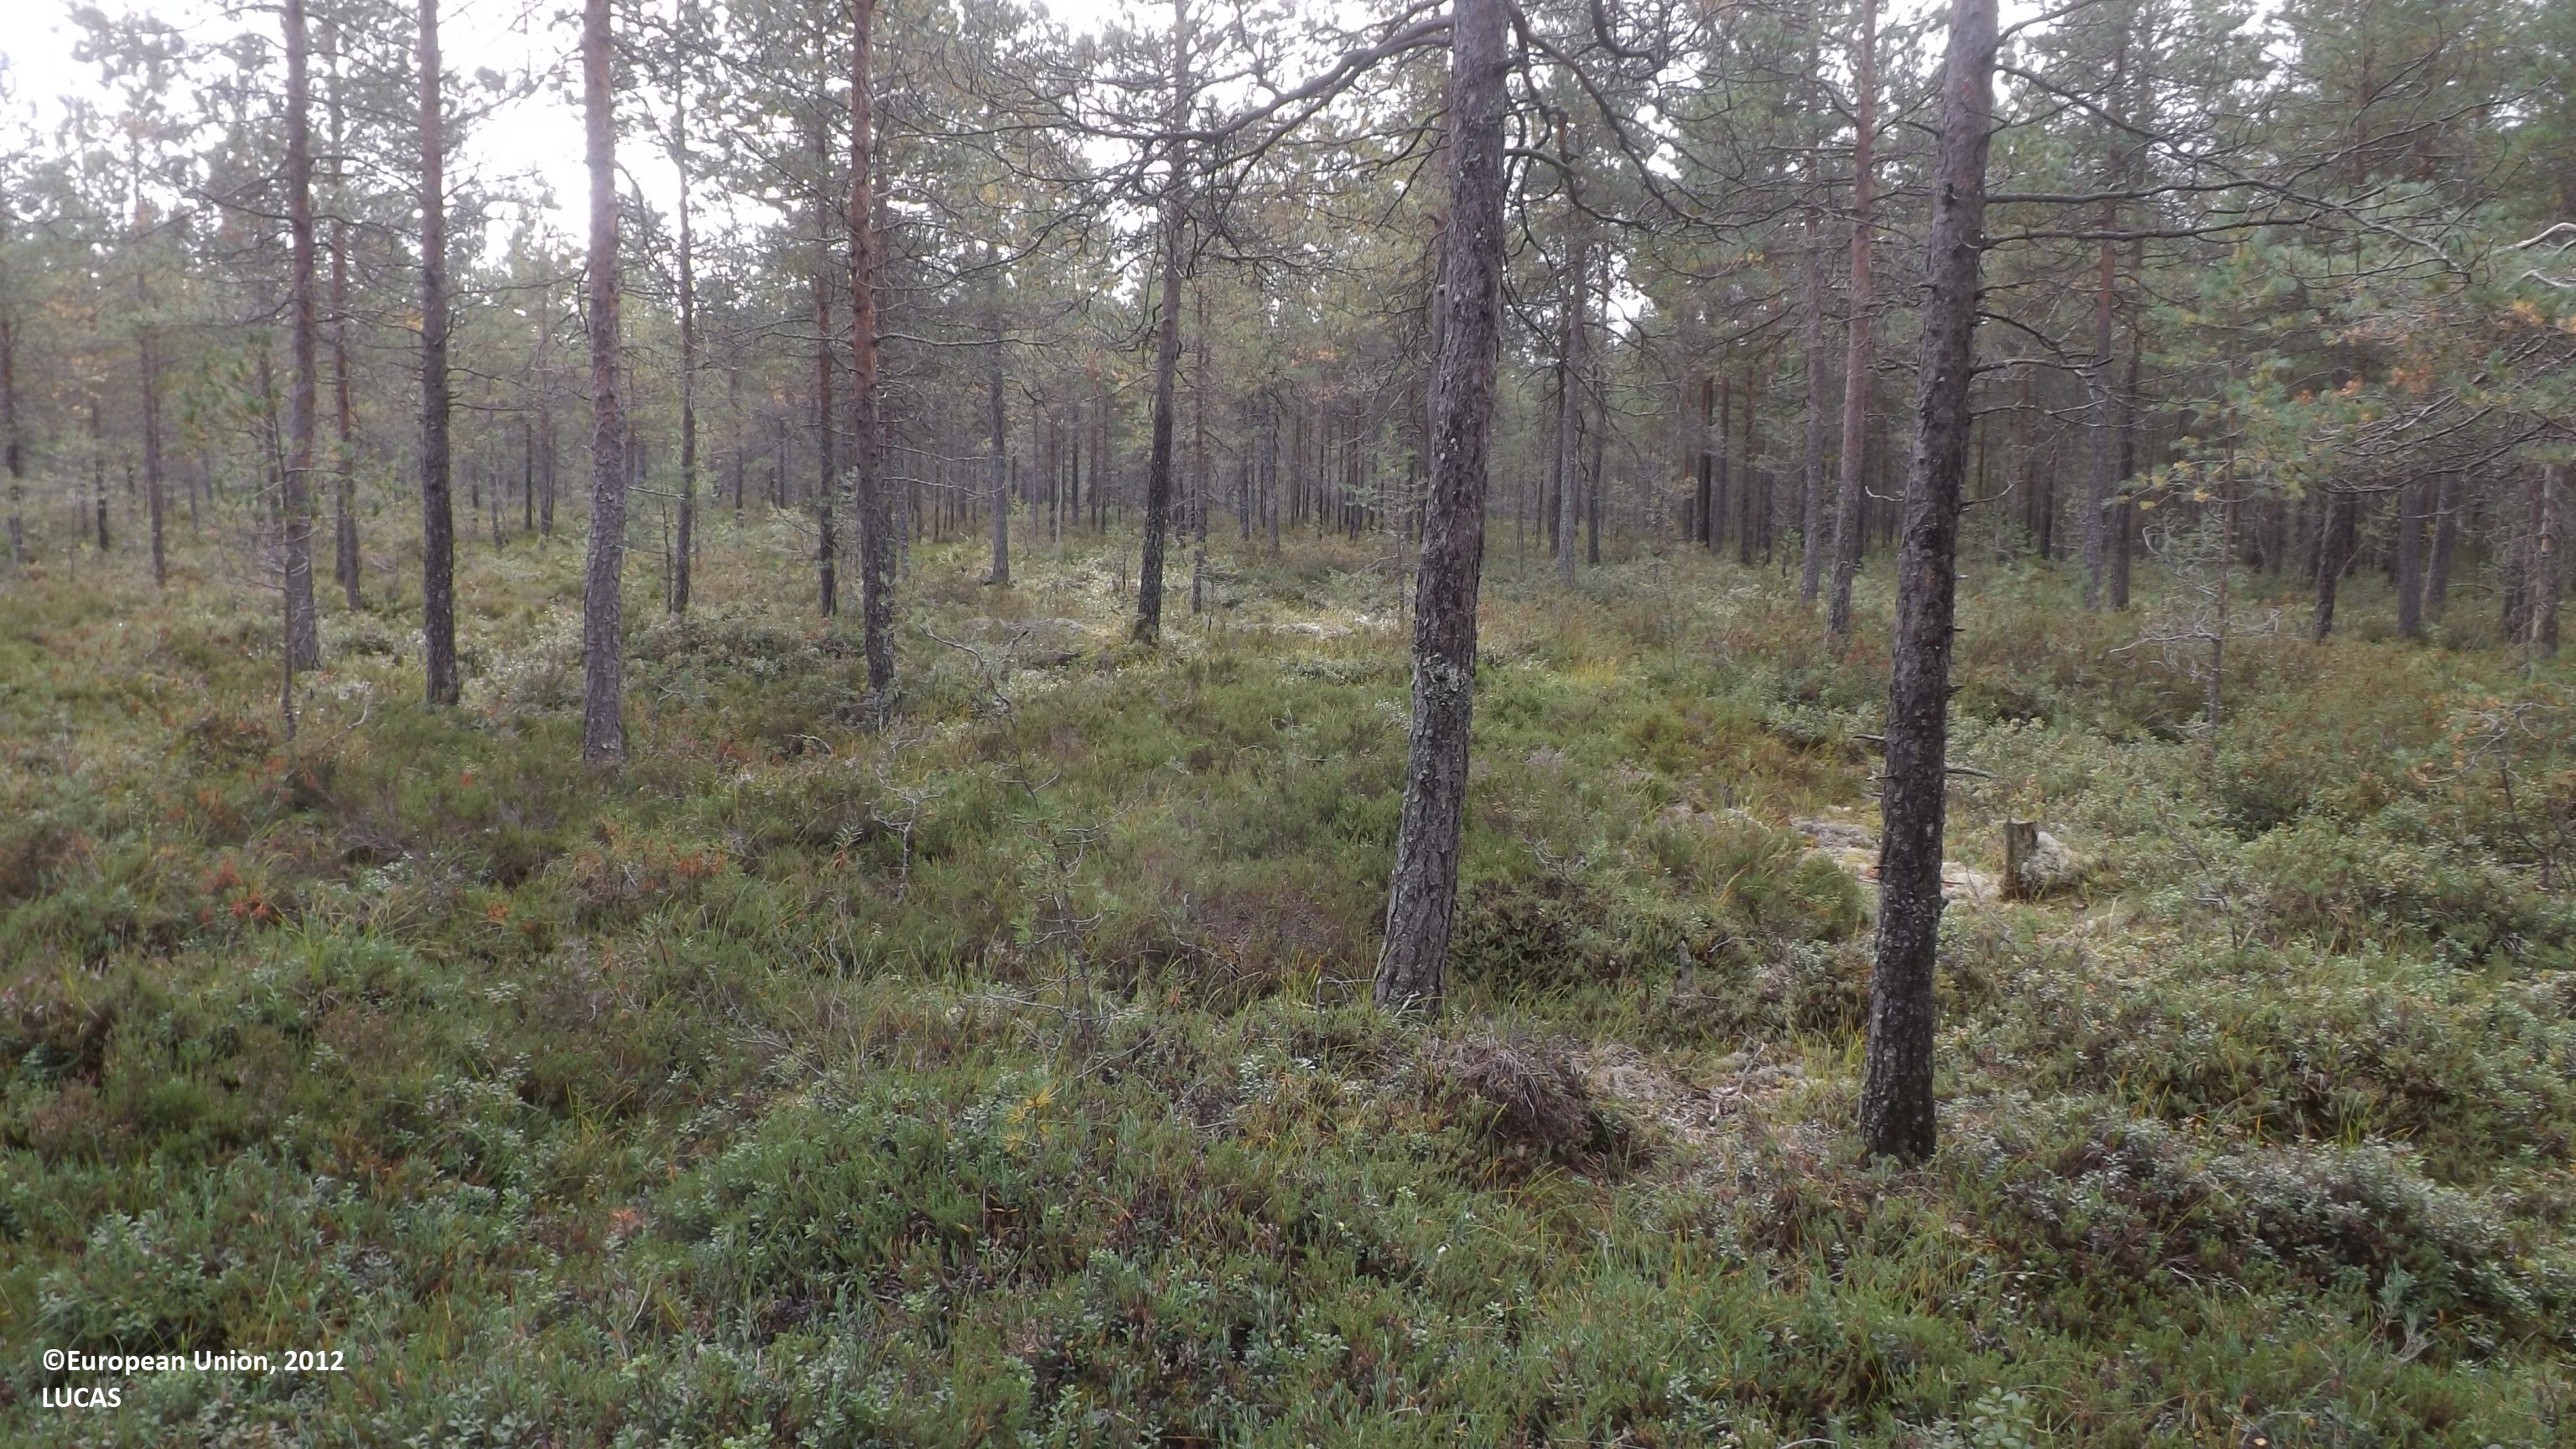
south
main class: Woodland
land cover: Pine dominated coniferous woodland
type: boreal forest
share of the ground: 25 - 50 %
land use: Forestry
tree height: > 5 m
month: August
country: FI
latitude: 63.9005
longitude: 23.6081
